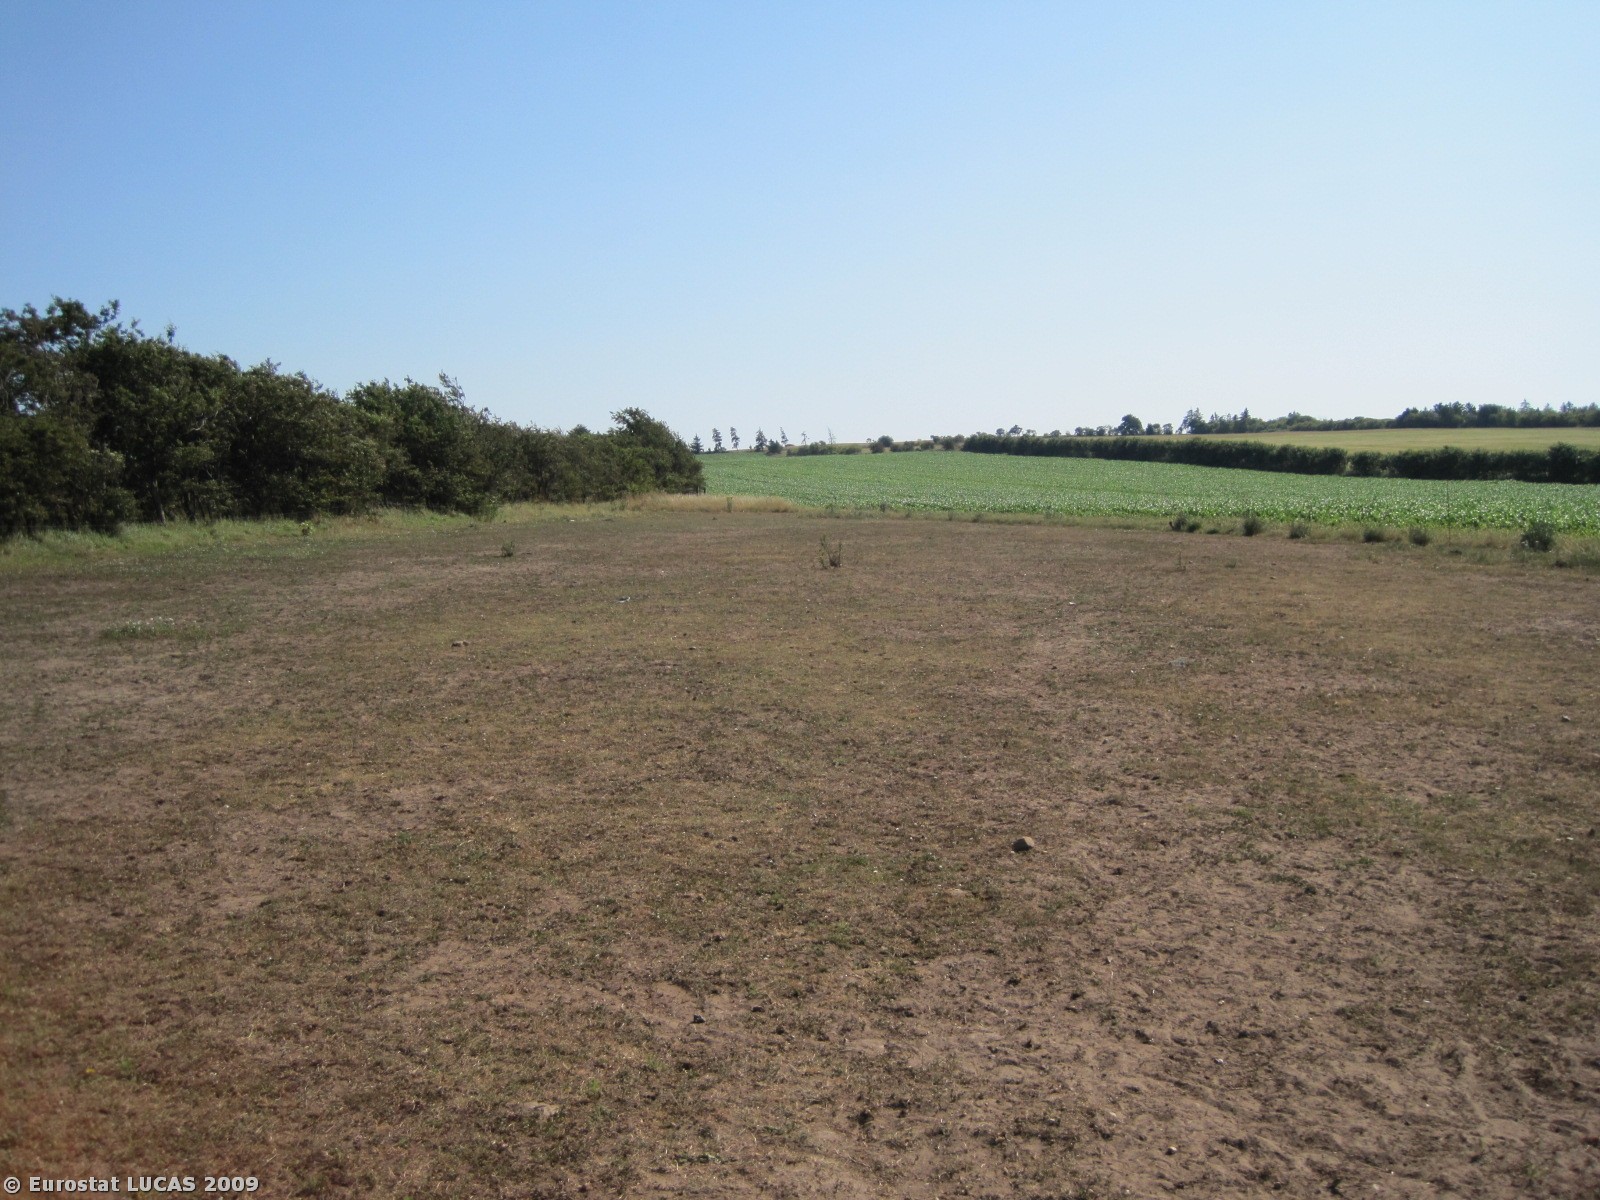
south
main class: Grassland
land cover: Grassland without tree/shrub cover
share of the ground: > 75 %
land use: Agriculture (excluding fallow land and kitchen gardens)
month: July
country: DK
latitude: 56.4127
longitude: 8.4945
